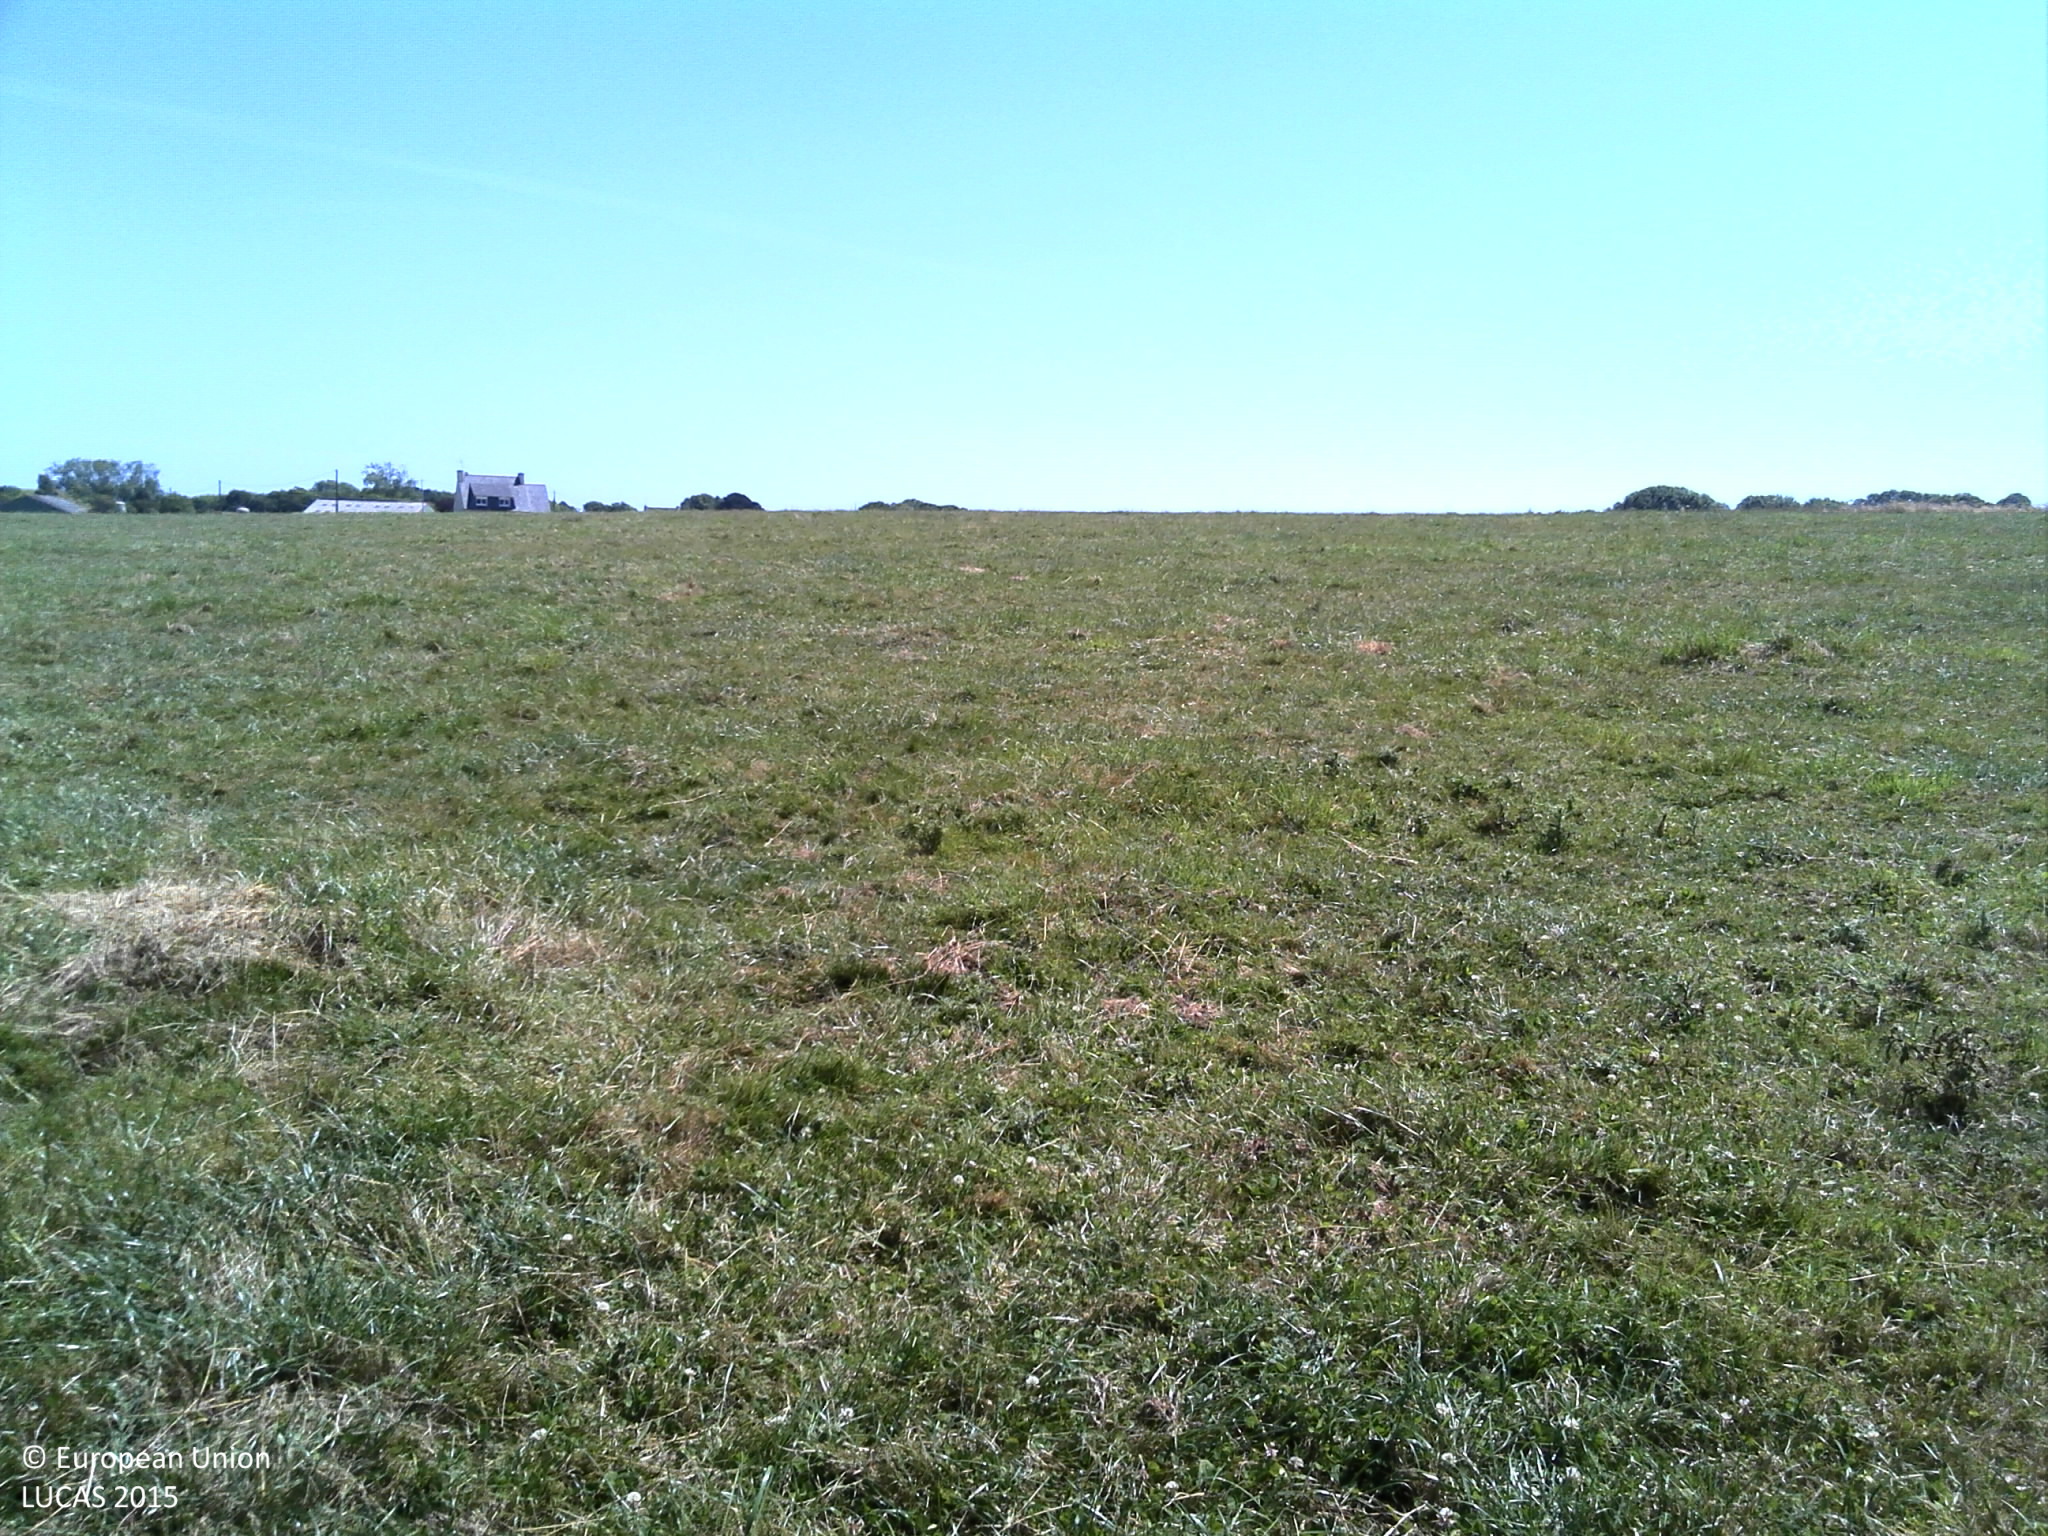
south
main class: Grassland
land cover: Grassland without tree/shrub cover
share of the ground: > 75 %
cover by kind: herbaceous plants 100 %
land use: Agriculture (excluding fallow land and kitchen gardens)
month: June
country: FR
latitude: 47.9365
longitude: -4.3493
